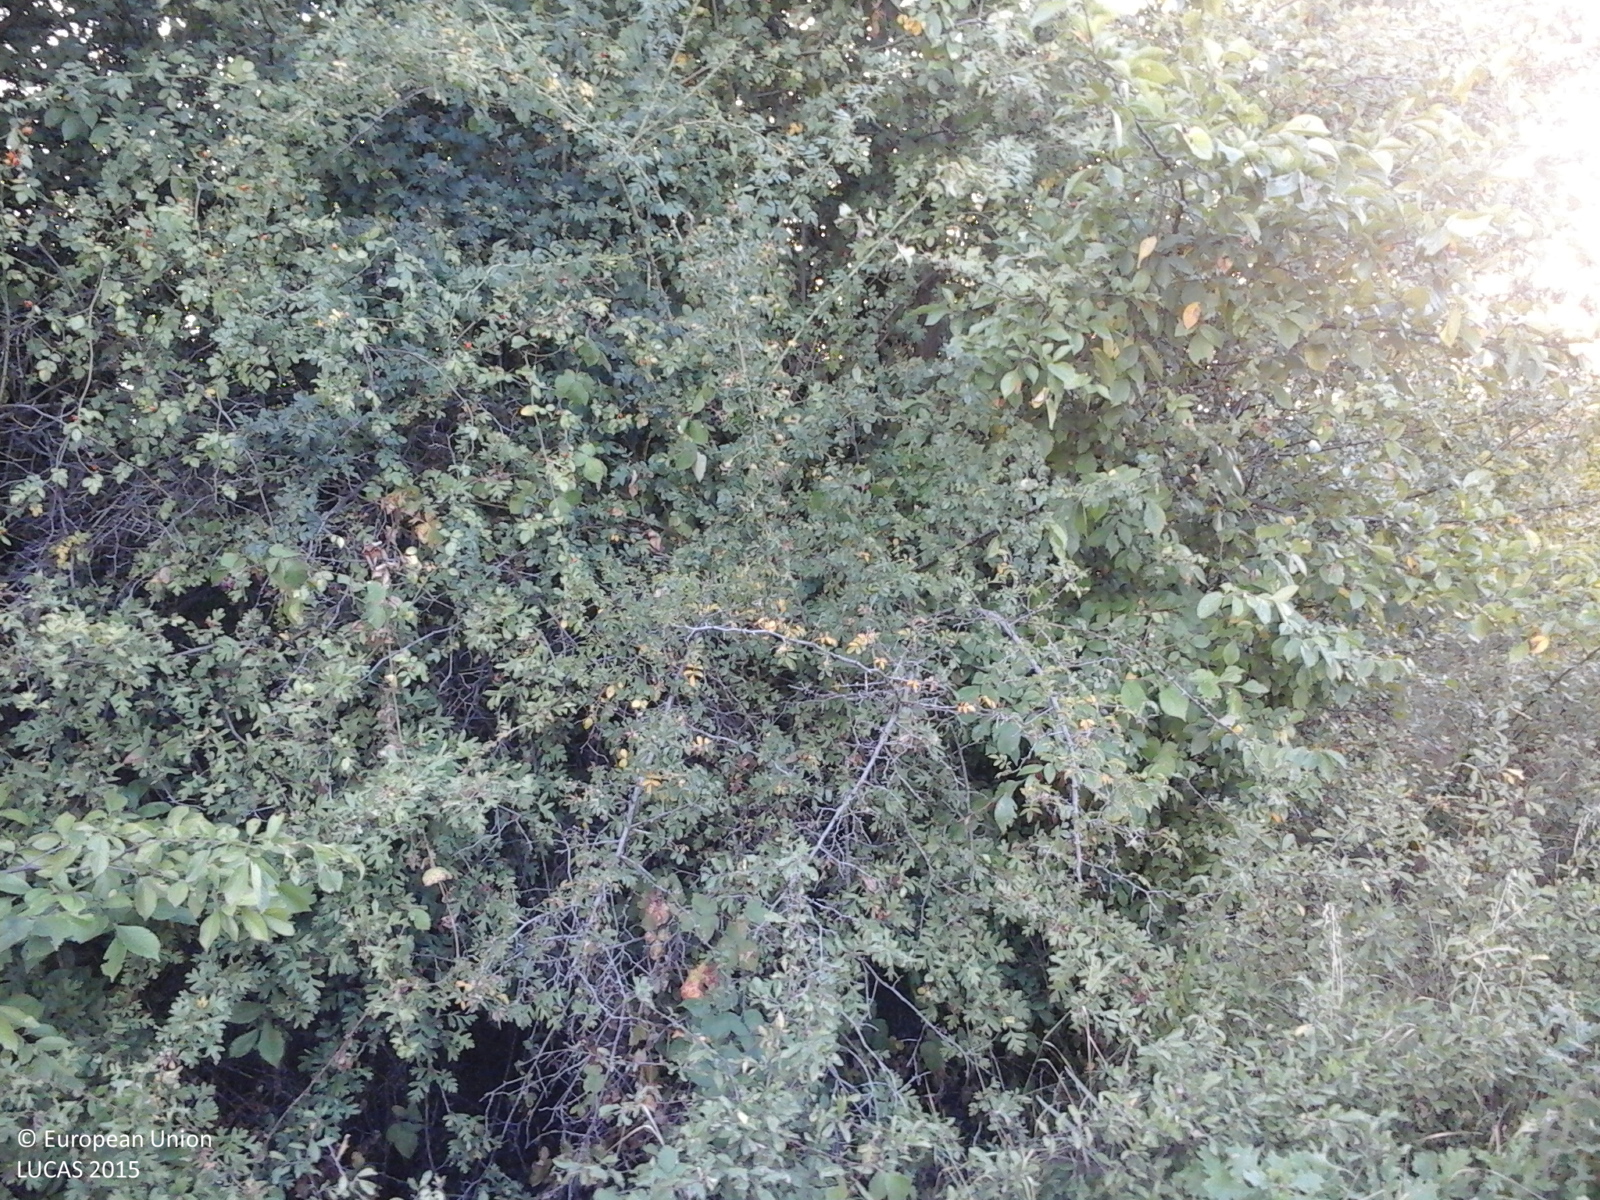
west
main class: Shrubland
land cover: Shrubland with sparse tree cover
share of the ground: > 75 %
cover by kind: shrubs 95 %, broadleaved forest trees 5 %
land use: Semi-natural and natural areas not in use
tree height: < 5 m
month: August
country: RO
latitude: 44.4276
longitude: 23.5317
